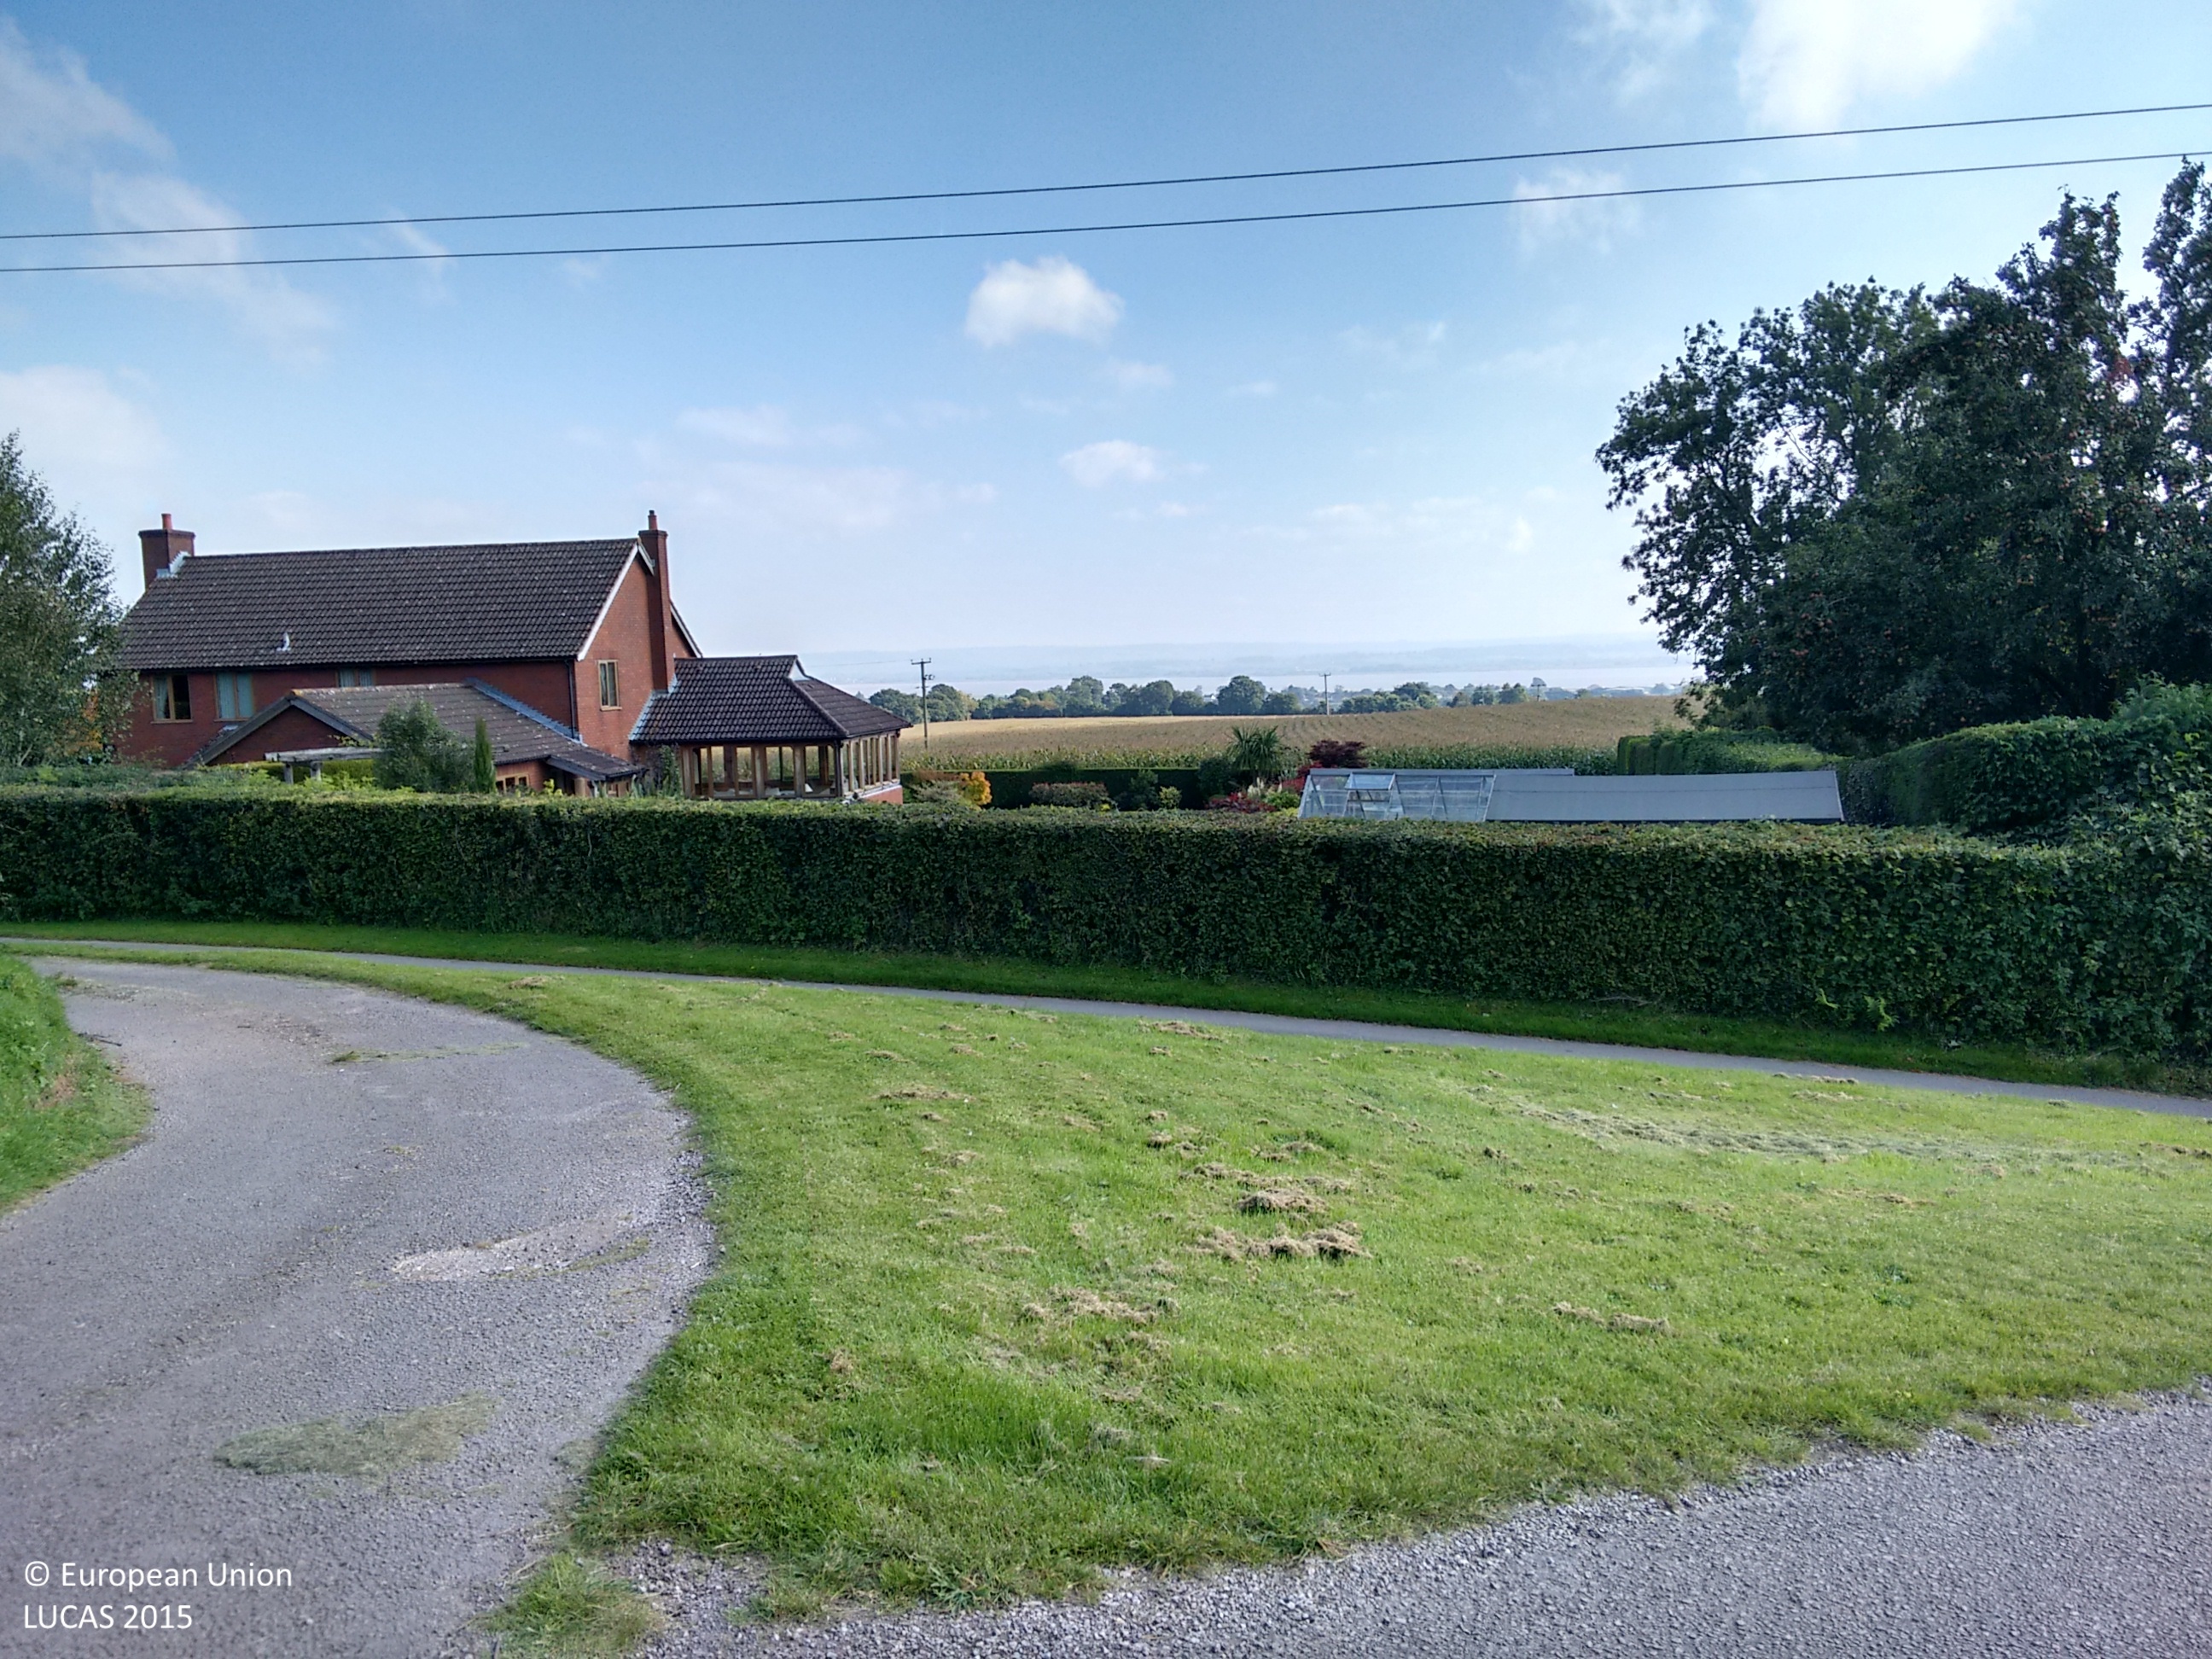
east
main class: Grassland
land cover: Grassland without tree/shrub cover
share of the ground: > 75 %
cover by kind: herbaceous plants 100 %
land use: Agriculture (excluding fallow land and kitchen gardens)
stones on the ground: < 10 %
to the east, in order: Grassland without tree/shrub cover; Fences; Managed hedges; Artificial constructions in urban areas; Managed hedges; Grass margins; Maize; Electric lines; Maize
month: October
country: GB
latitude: 51.7013
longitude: -2.6134
